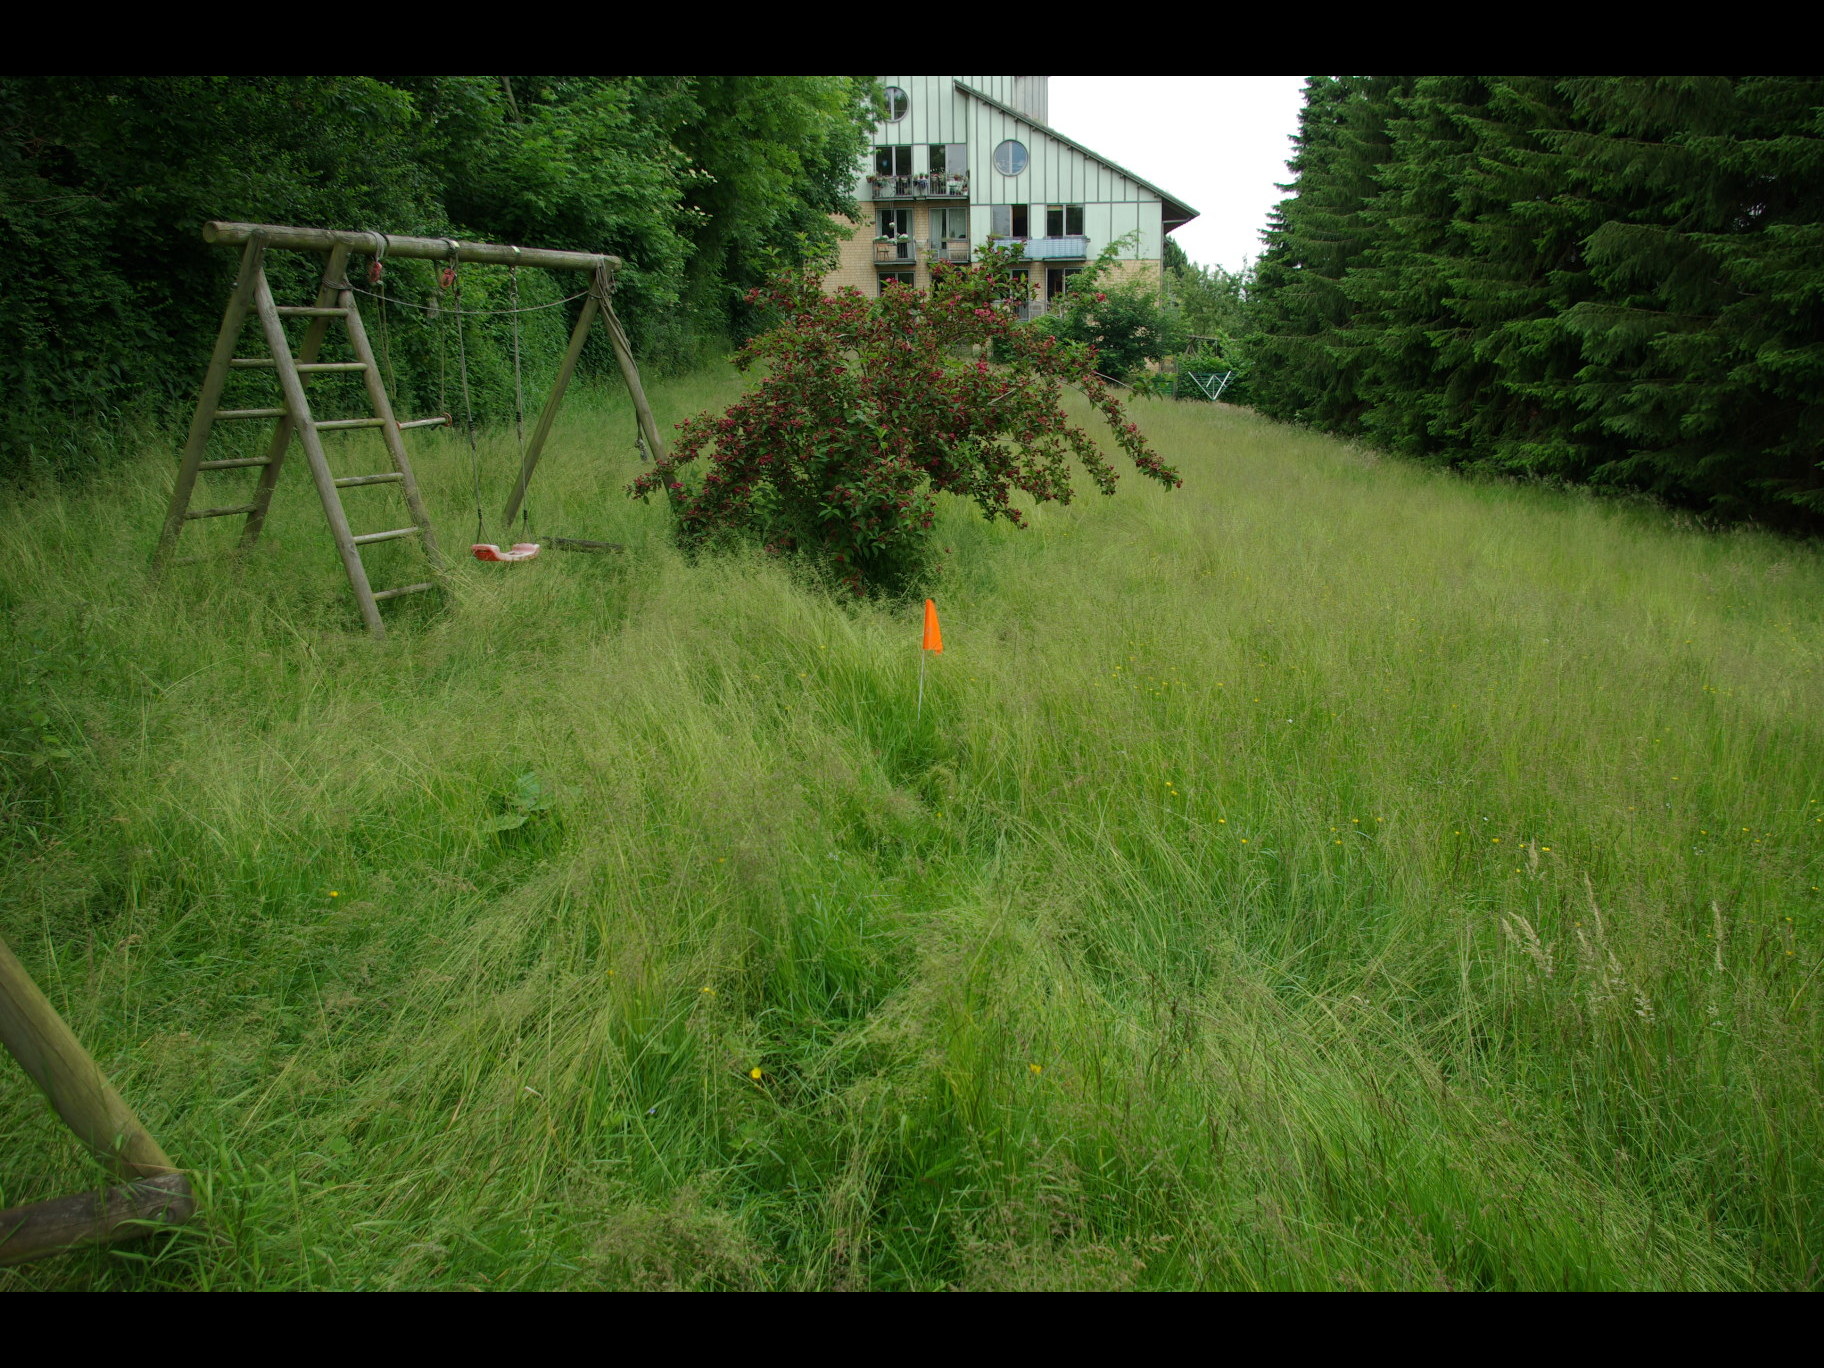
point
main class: Grassland
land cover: Grassland without tree/shrub cover
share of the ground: > 75 %
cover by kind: herbaceous plants 95 %, shrubs 5 %
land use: Residential
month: June
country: DE
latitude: 54.4622
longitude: 9.8304
